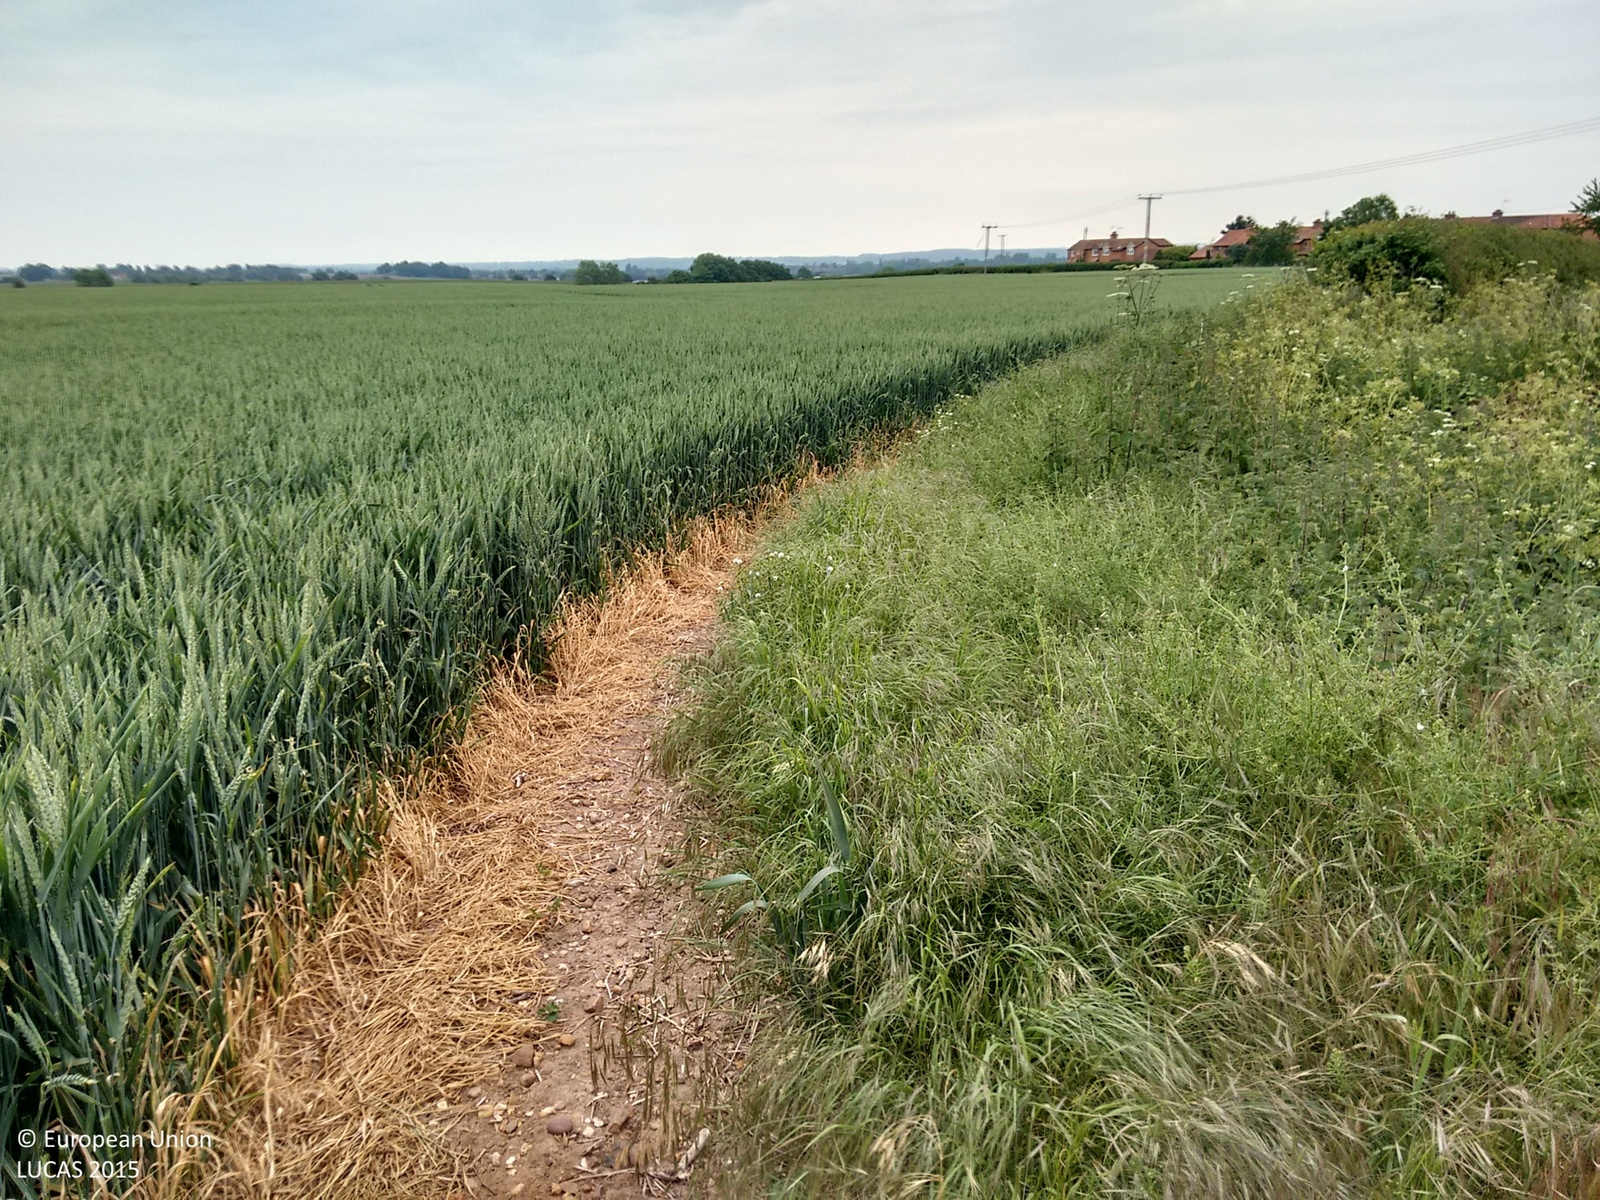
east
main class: Cropland
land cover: Common wheat
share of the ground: > 75 %
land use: Agriculture (excluding fallow land and kitchen gardens)
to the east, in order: Common wheat
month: June
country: GB
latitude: 52.2184
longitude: -1.6607
